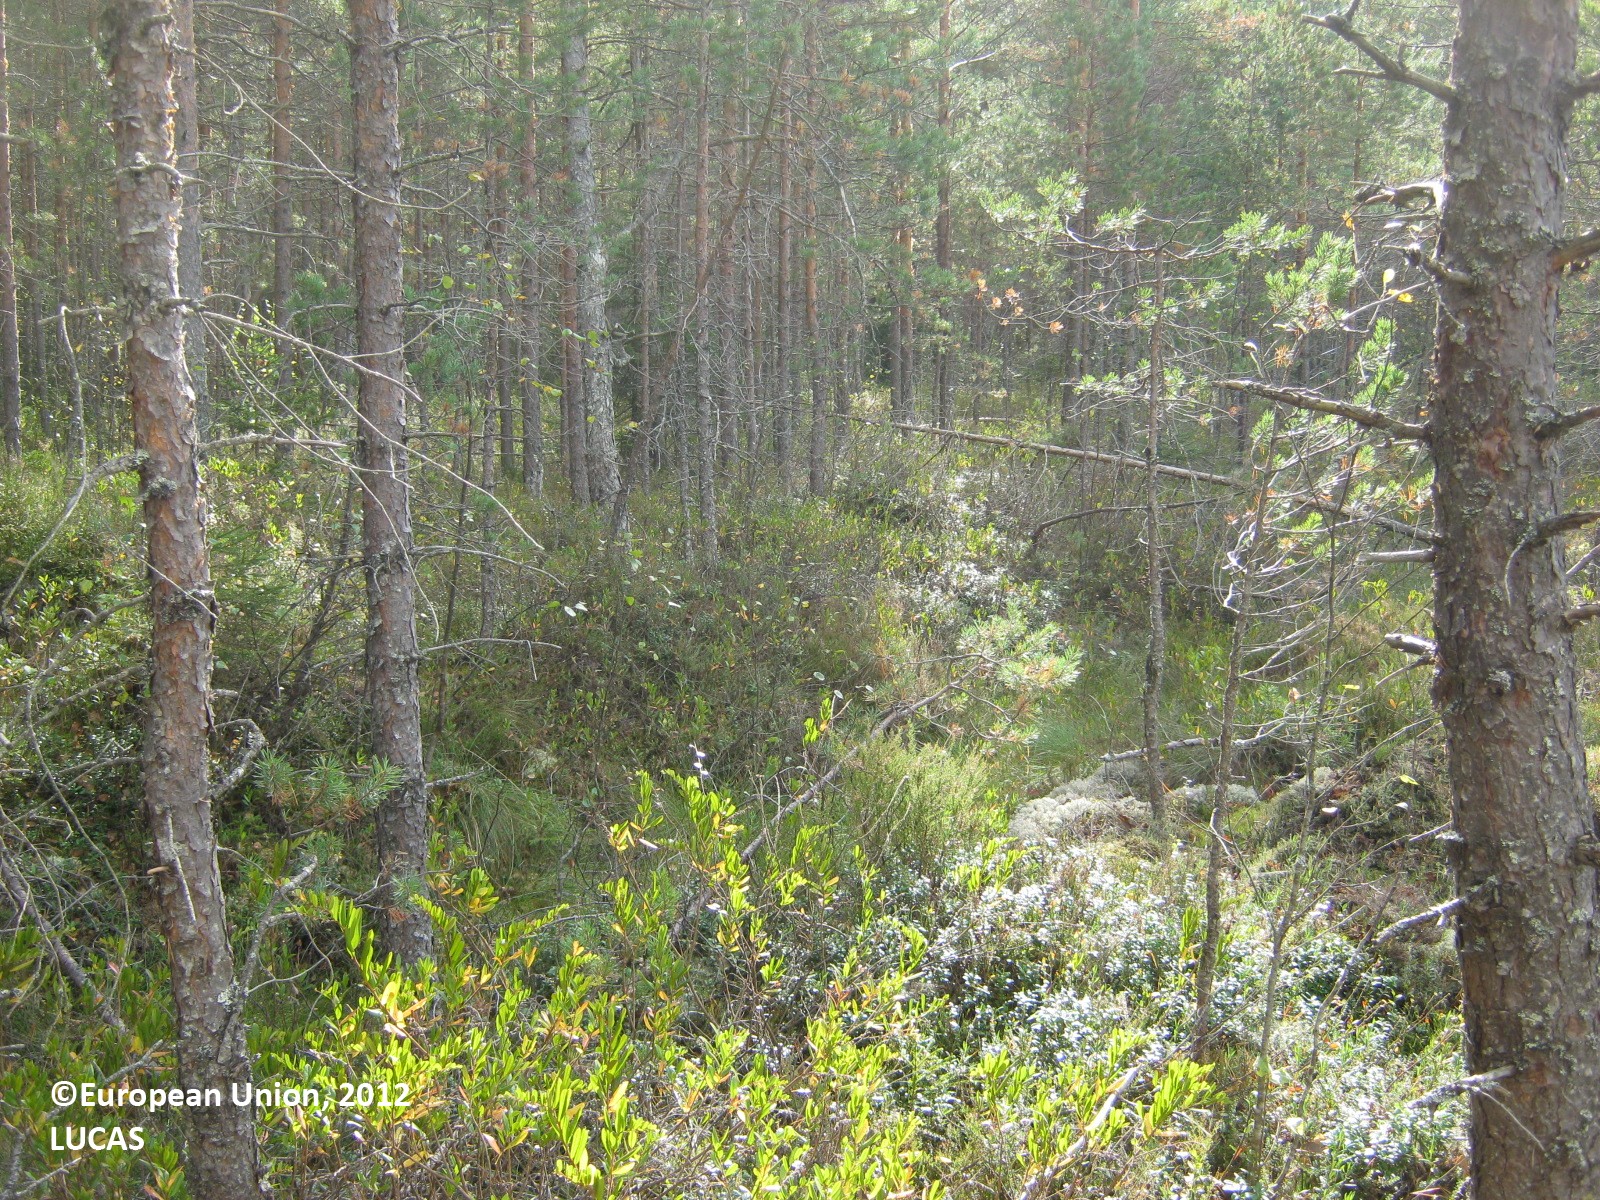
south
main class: Woodland
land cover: Pine dominated coniferous woodland
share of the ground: 50 - 75 %
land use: Forestry
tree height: < 5 m
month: September
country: FI
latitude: 60.9818
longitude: 28.2253
